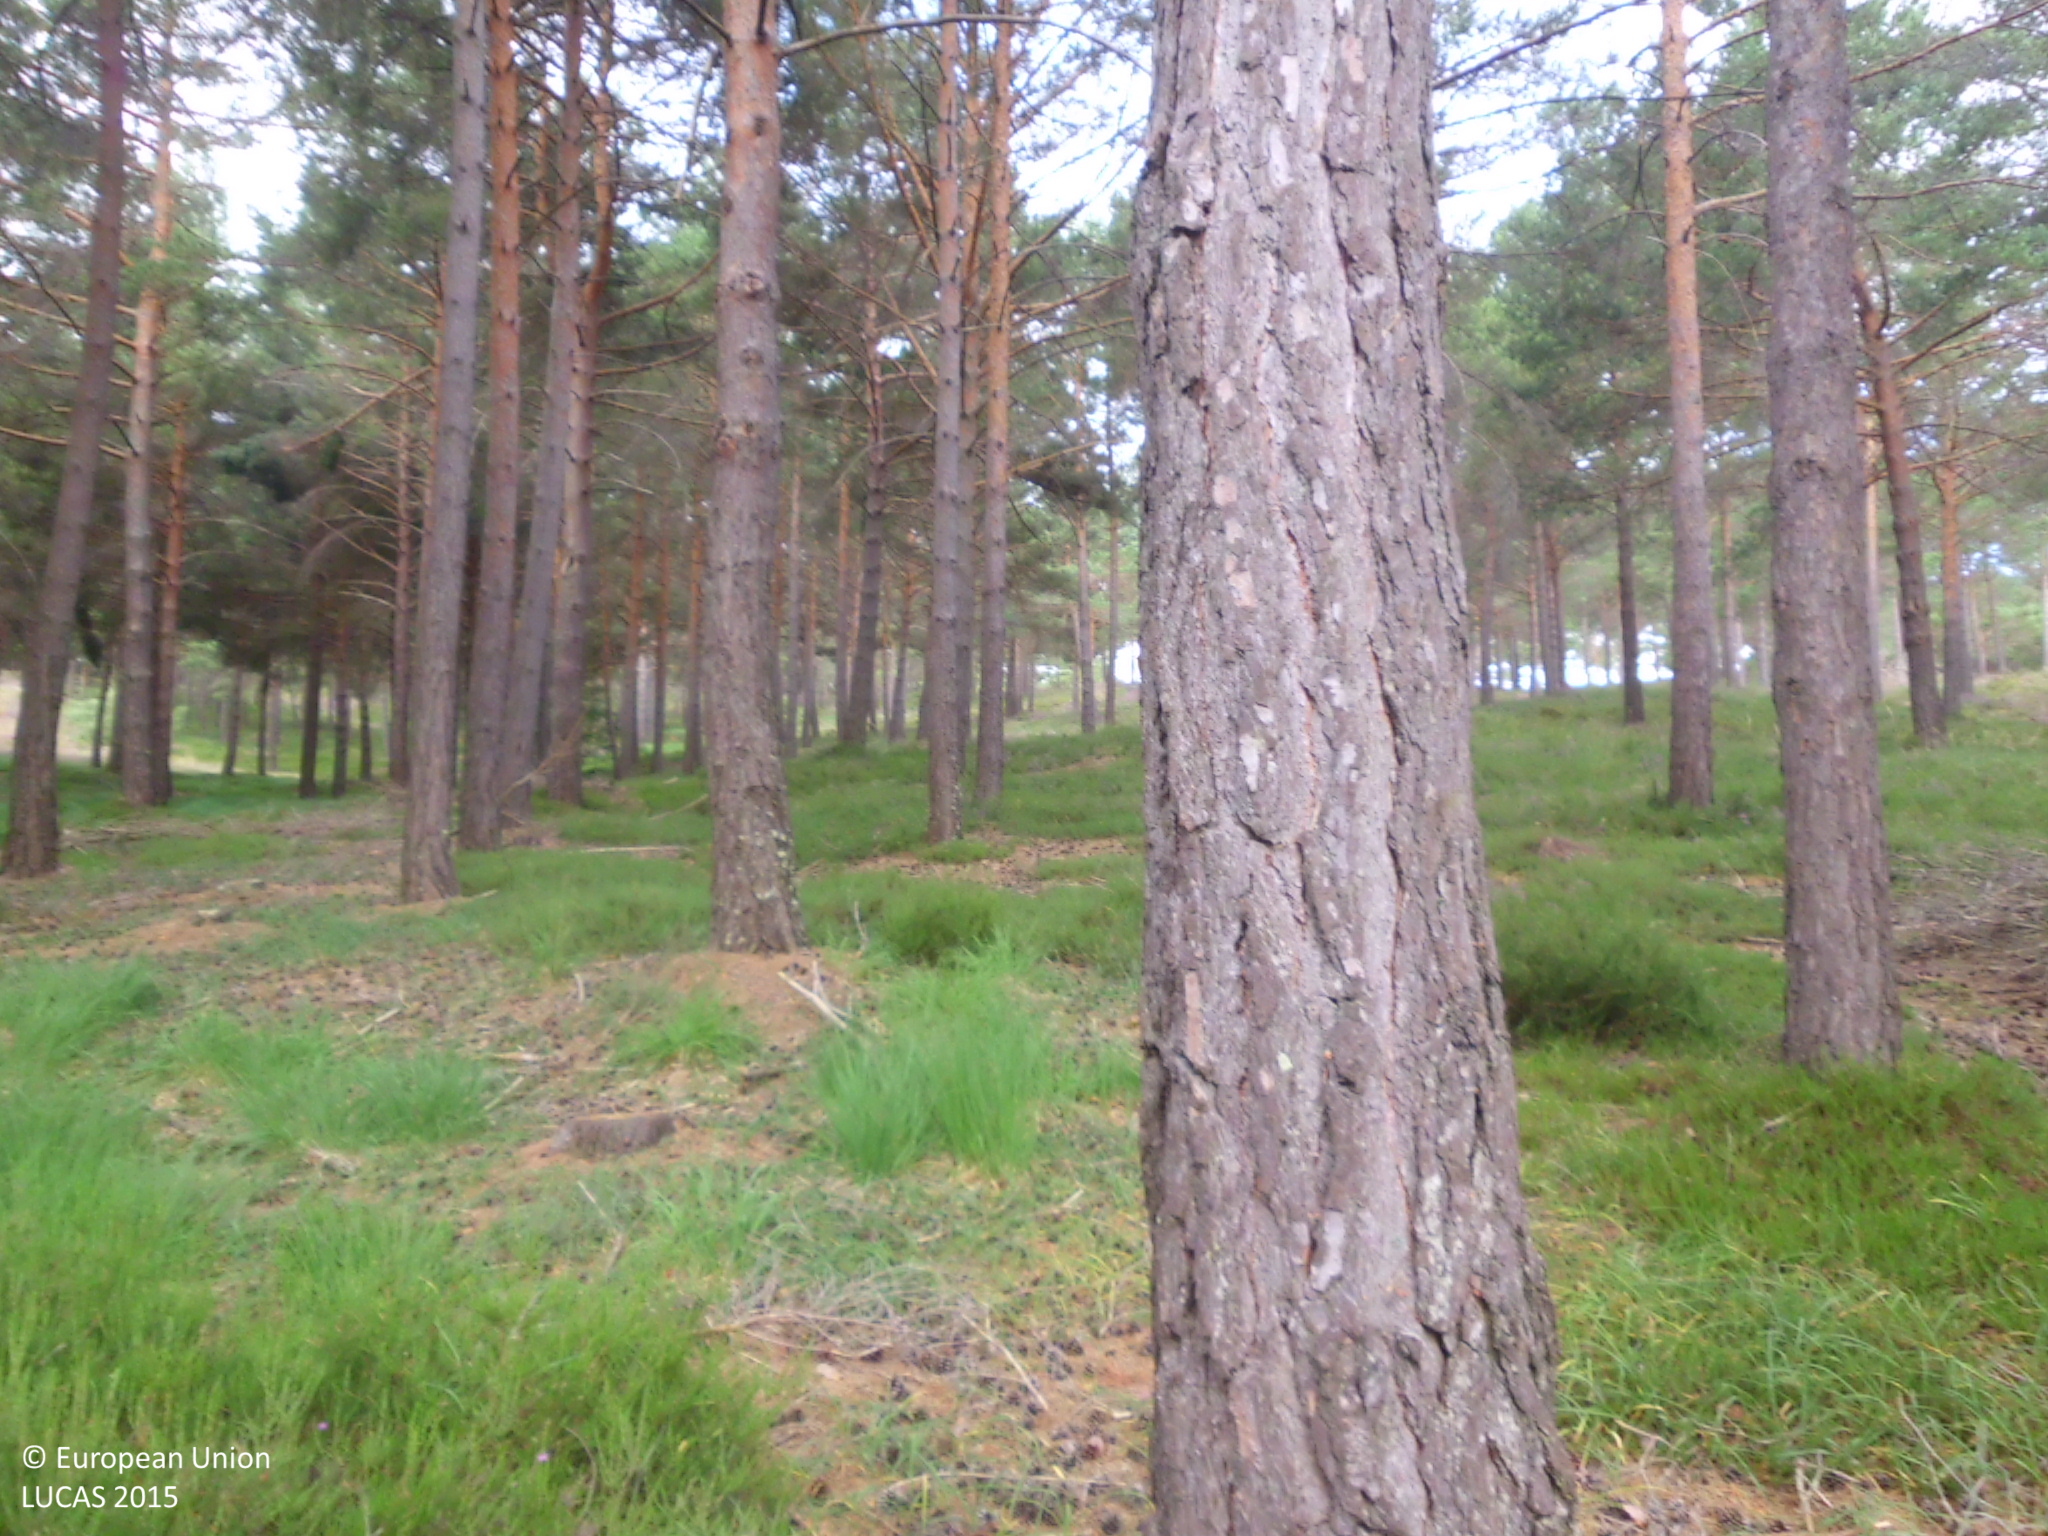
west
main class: Woodland
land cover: Pine dominated coniferous woodland
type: coniferous forest of the mediterranean region
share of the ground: > 75 %
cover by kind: coniferous forest trees 80 %, consolidated bare surface 15 %, shrubs 5 %
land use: Forestry
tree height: > 5 m
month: July
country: ES
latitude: 42.6835
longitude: -3.9940
